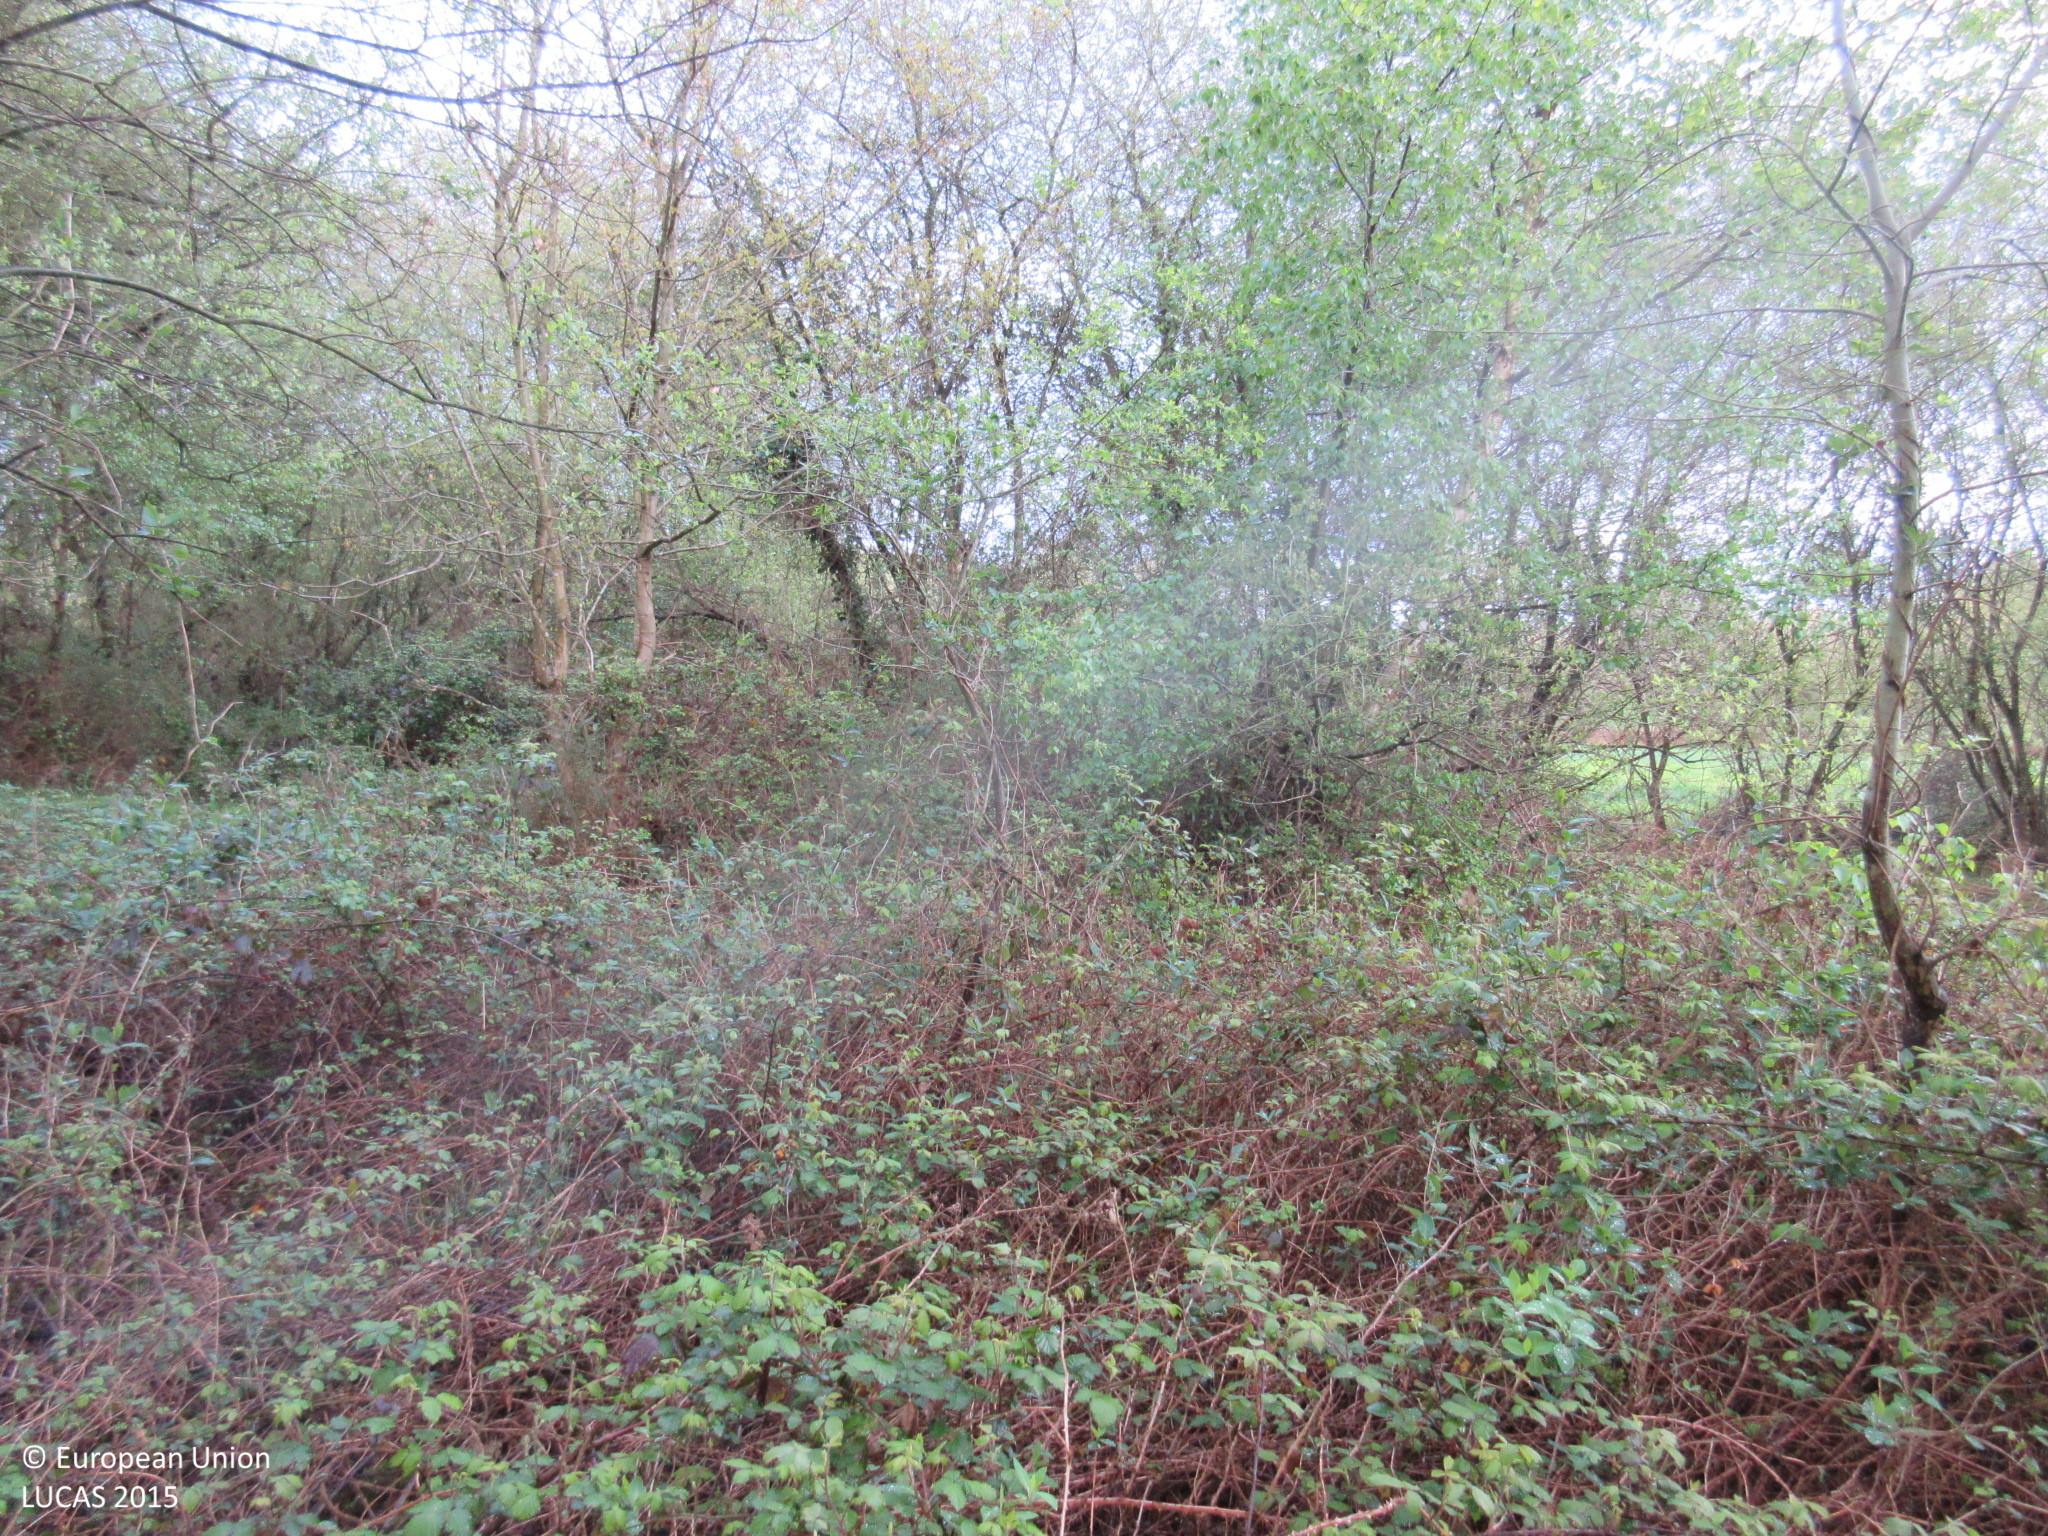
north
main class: Woodland
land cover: Broadleaved woodland
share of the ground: > 75 %
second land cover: Shrubland without tree cover
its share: 10 - 25 %
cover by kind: broadleaved forest trees 80 %, shrubs 10 %, herbaceous plants 10 %
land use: Forestry
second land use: Agriculture (excluding fallow land and kitchen gardens)
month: April
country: ES
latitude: 43.5186
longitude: -5.3067
